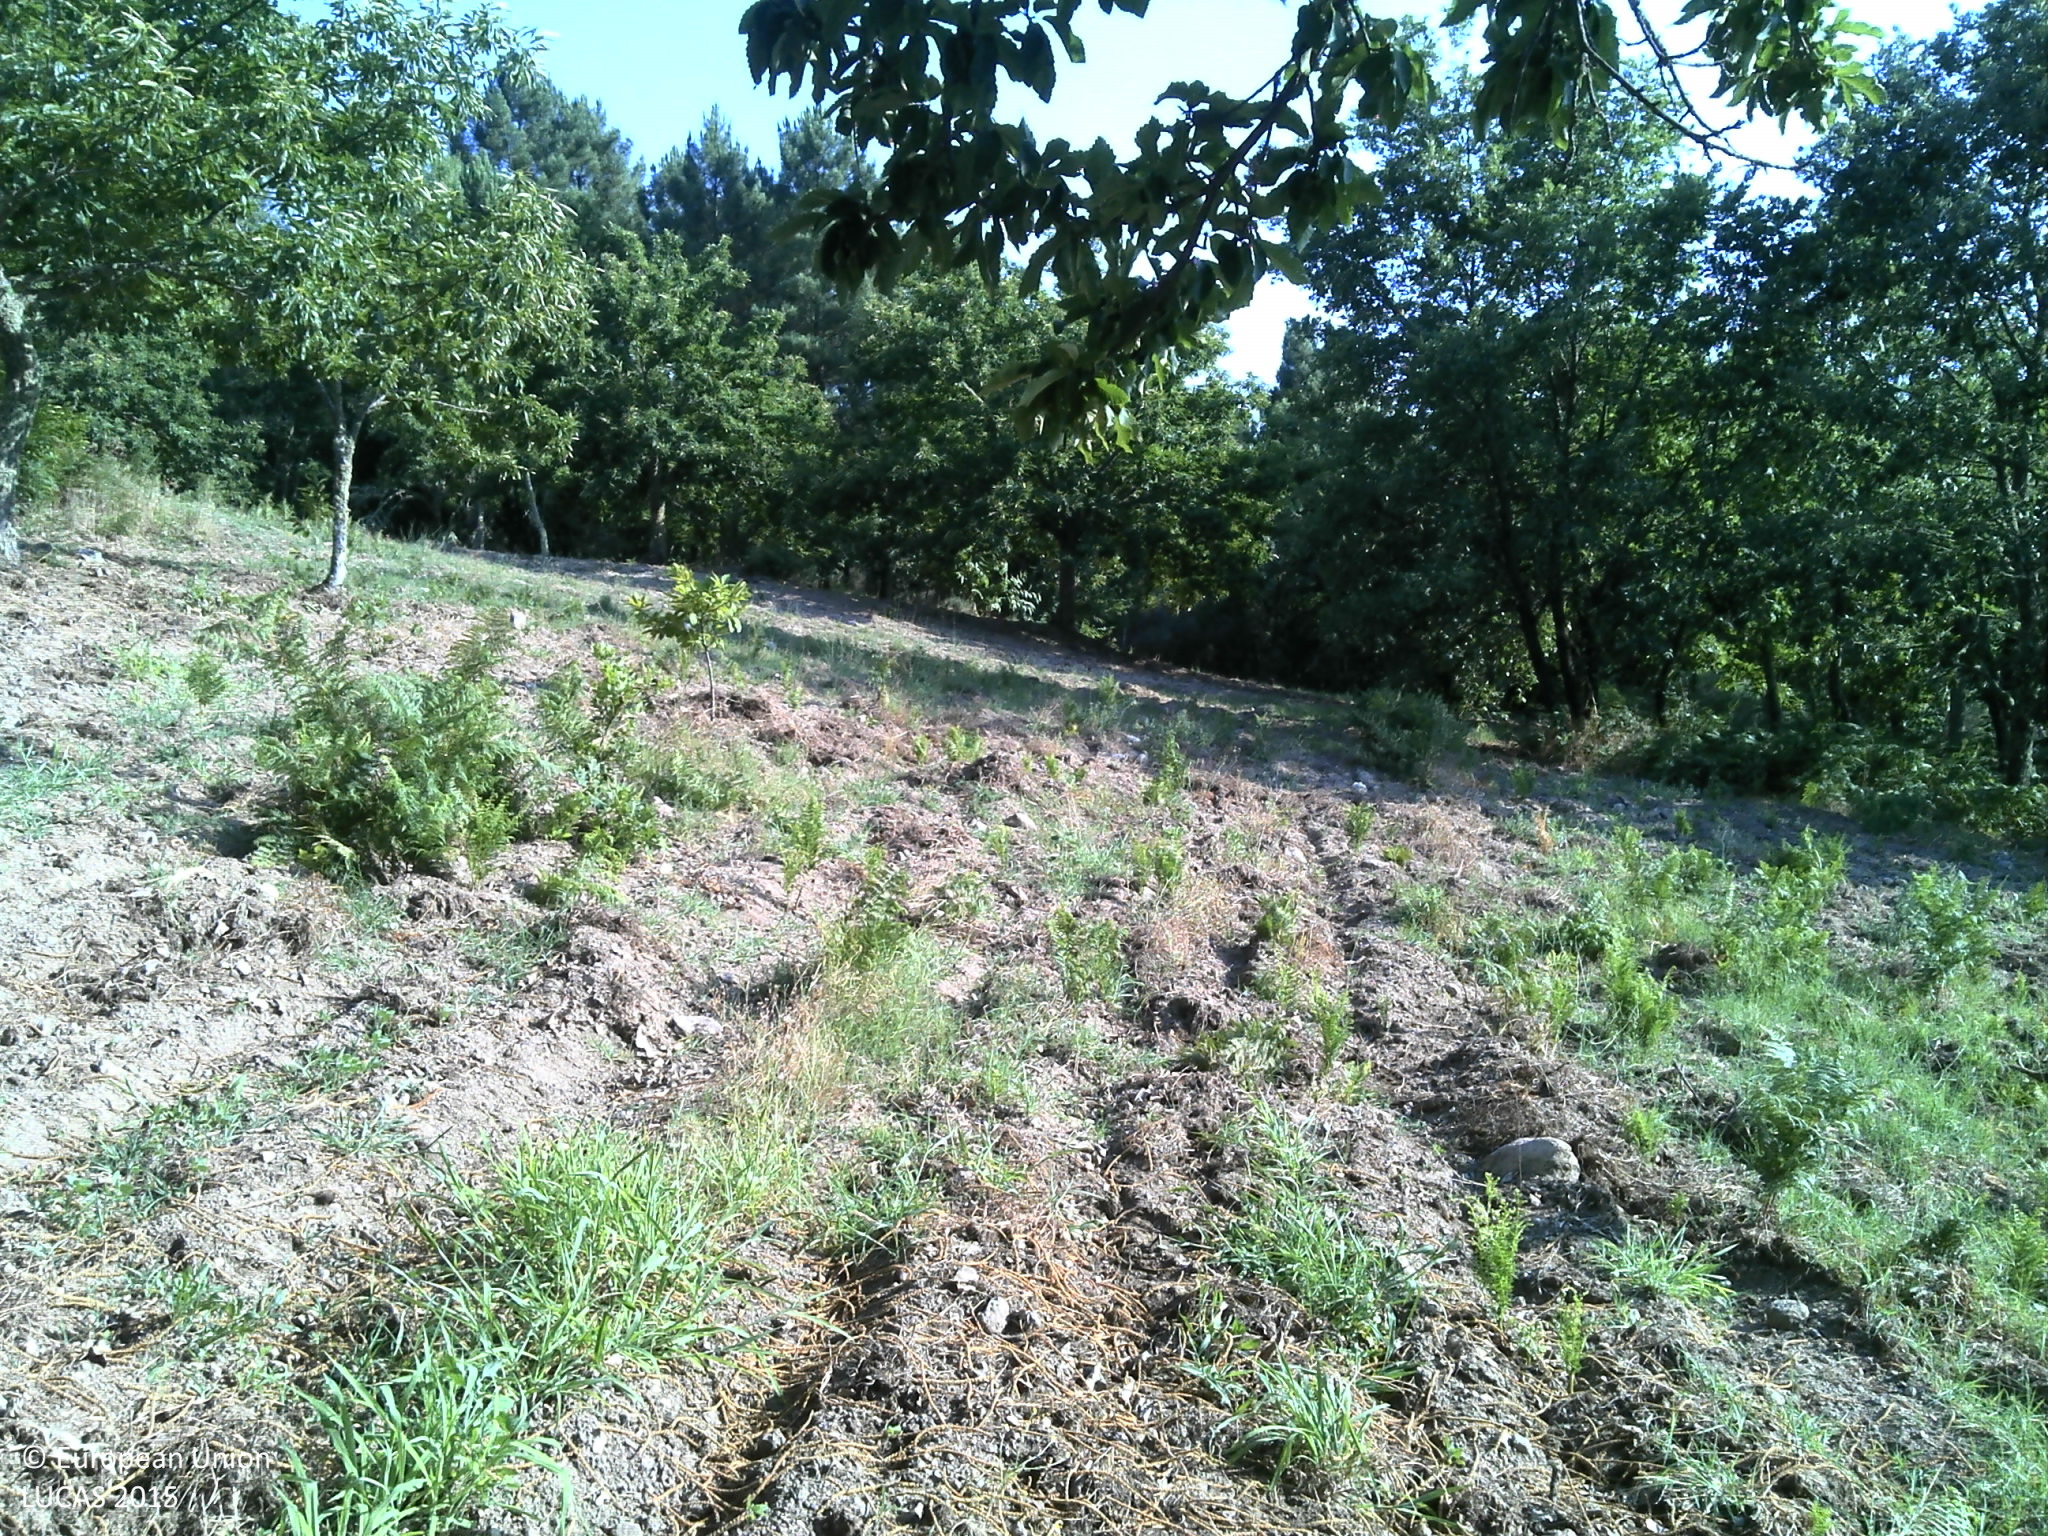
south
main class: Cropland
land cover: Nuts trees
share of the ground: 25 - 50 %
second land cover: Spontaneously vegetated surfaces
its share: 10 - 25 %
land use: Agriculture (excluding fallow land and kitchen gardens)
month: July
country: PT
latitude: 40.8939
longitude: -7.5065
